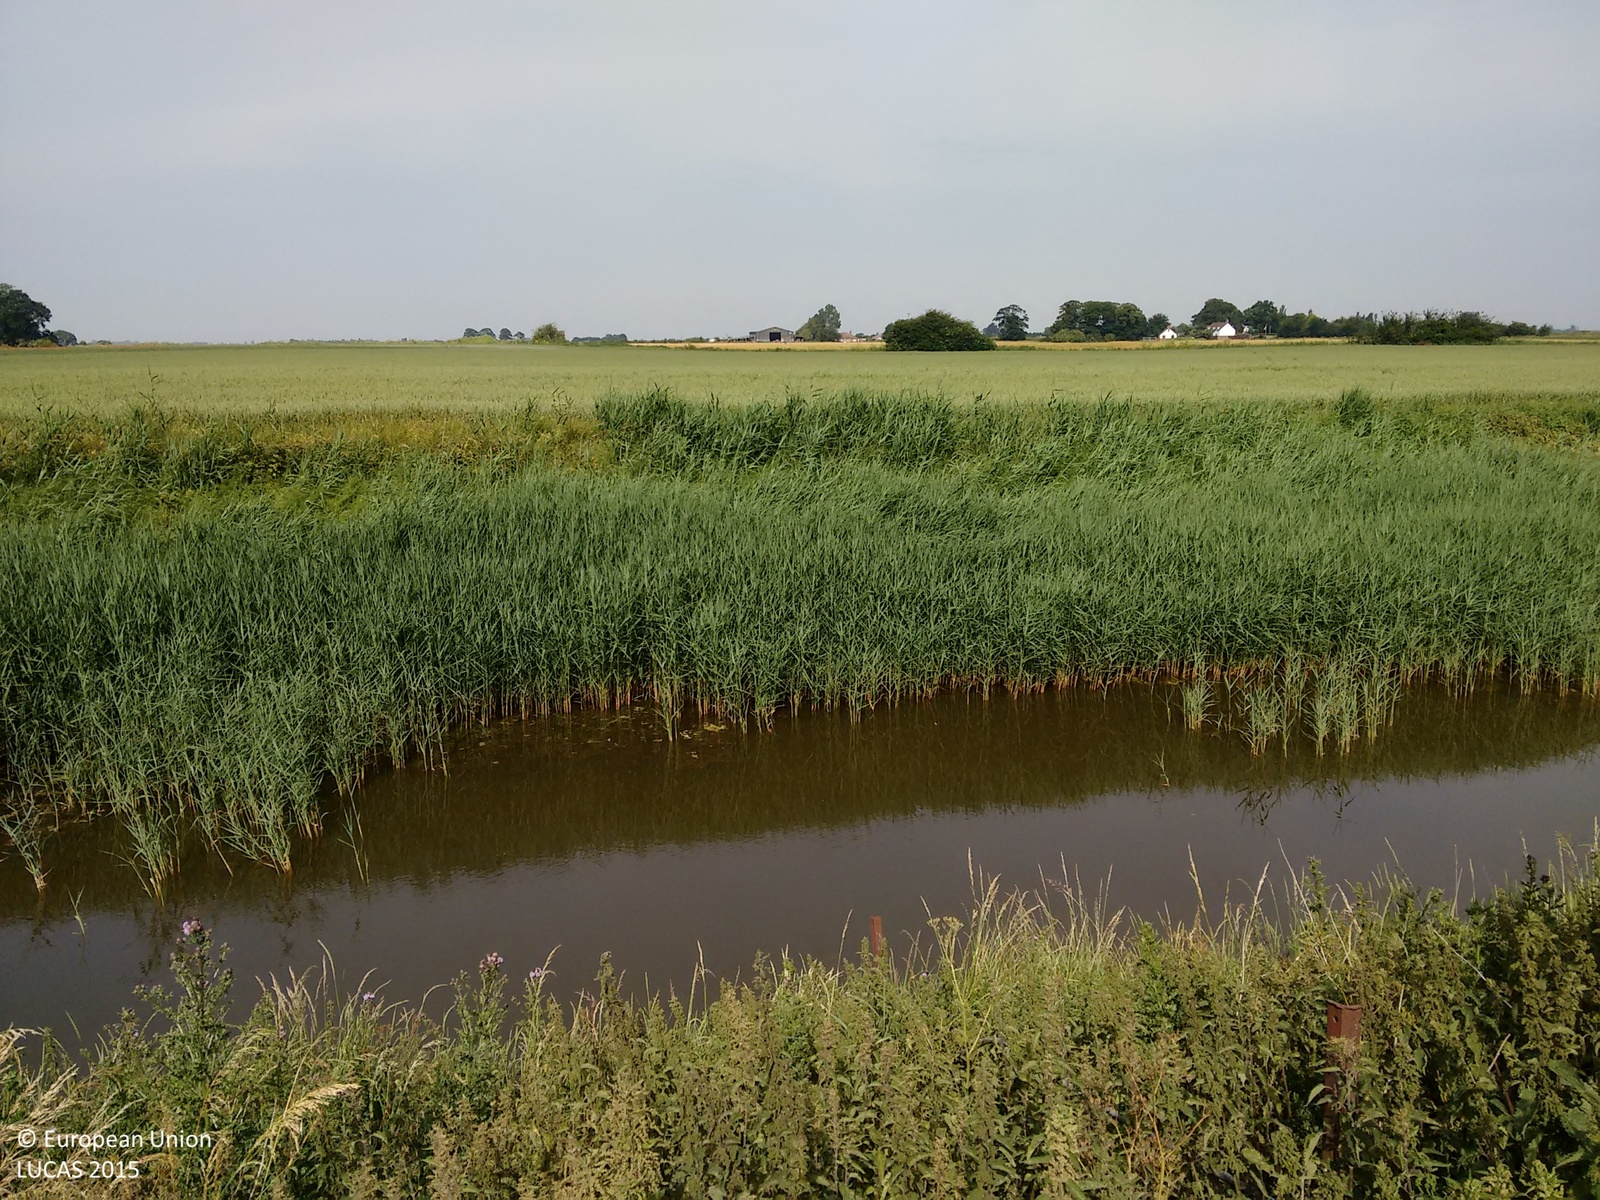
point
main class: Cropland
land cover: Arable land (only in case pi)
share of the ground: > 75 %
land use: Agriculture (excluding fallow land and kitchen gardens)
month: July
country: GB
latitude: 52.6623
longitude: 0.0172
